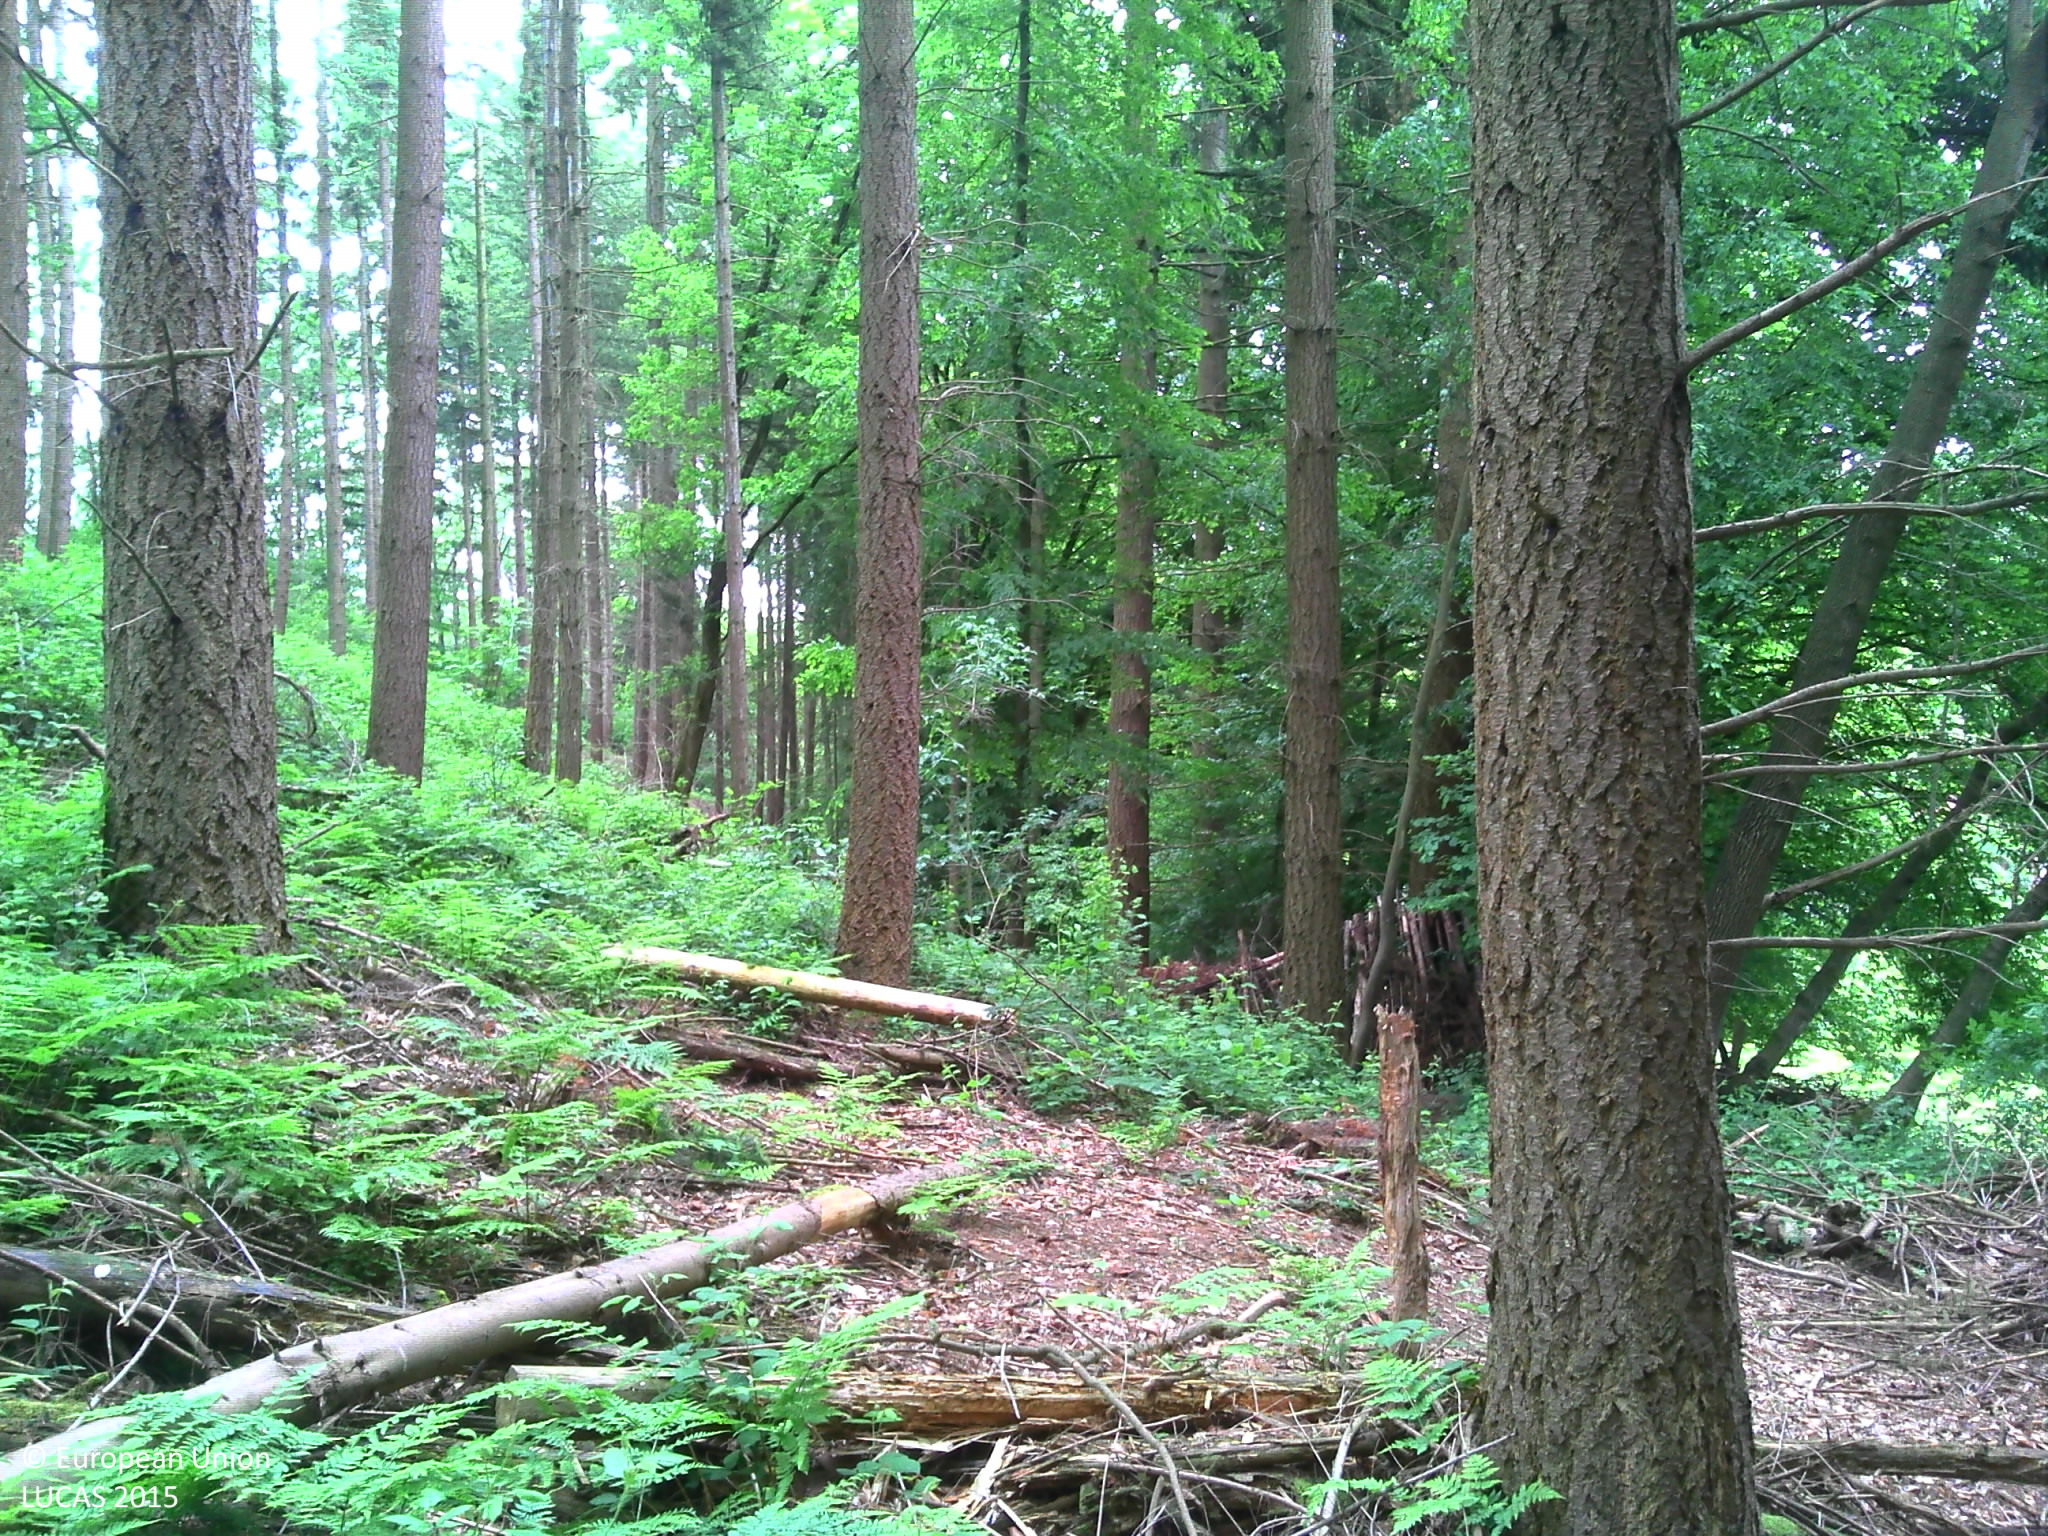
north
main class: Woodland
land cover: Other coniferous woodland
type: exotic forest
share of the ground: > 75 %
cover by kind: coniferous forest trees 90 %, herbaceous plants 10 %
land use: Forestry
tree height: > 5 m
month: June
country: BE
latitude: 50.3884
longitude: 5.6242
